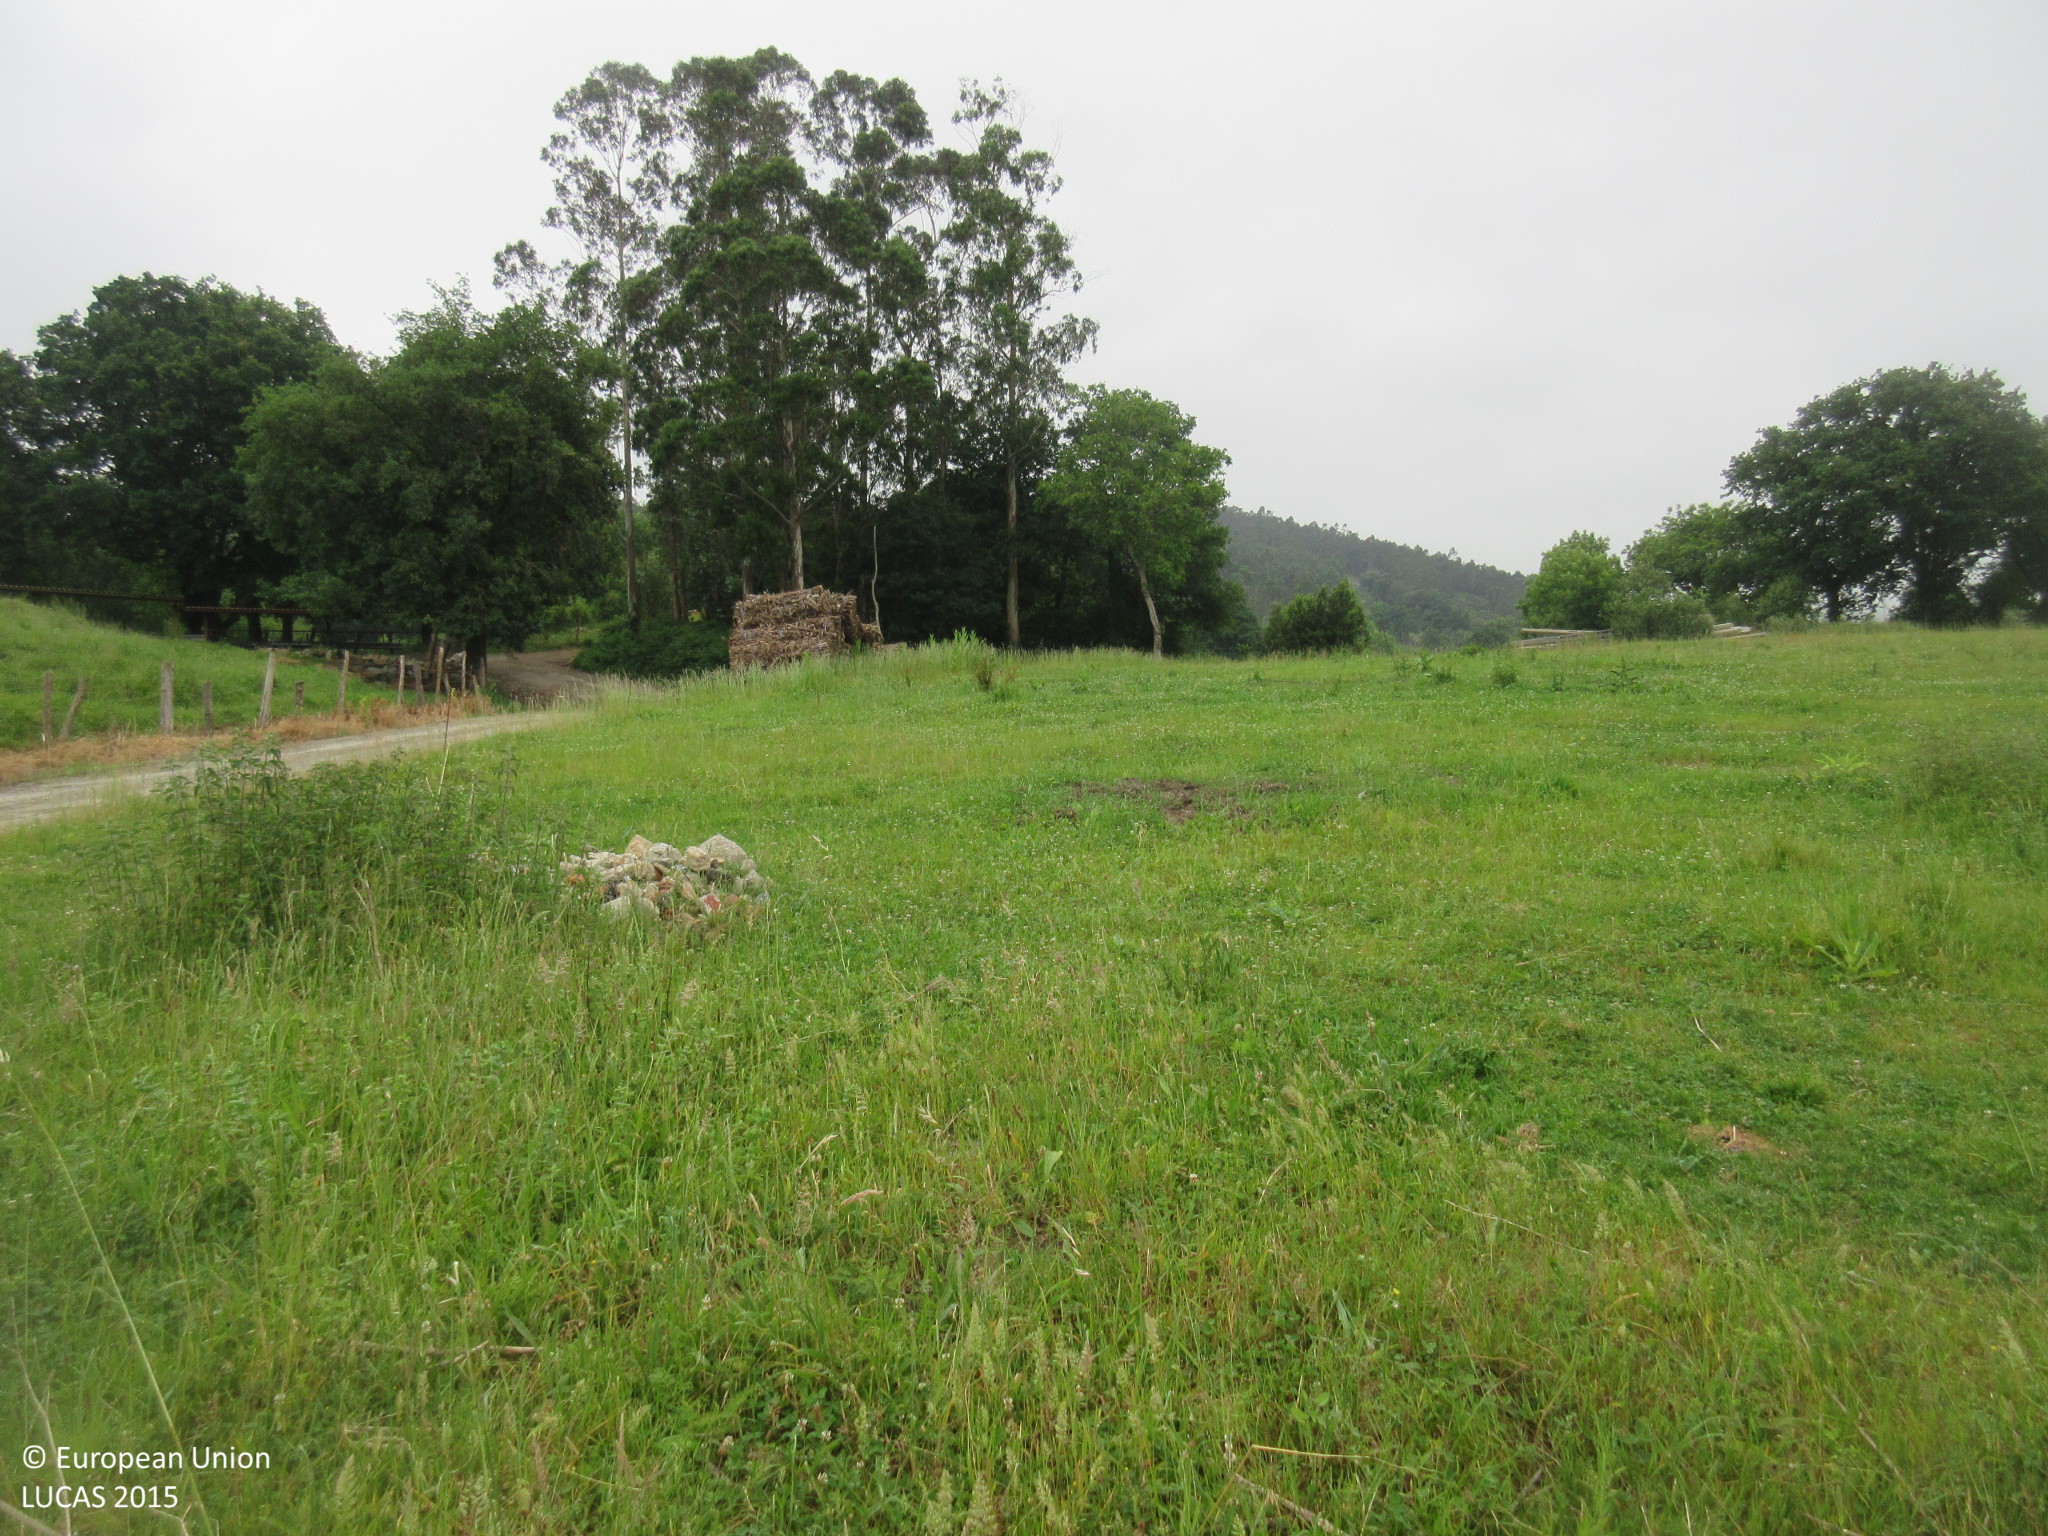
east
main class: Grassland
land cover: Grassland without tree/shrub cover
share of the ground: > 75 %
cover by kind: herbaceous plants 100 %
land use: Agriculture (excluding fallow land and kitchen gardens)
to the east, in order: Grassland without tree/shrub cover; Tracks; Broadleaved woodland; Fences; Tracks; Shruby margins; Fences; Grassland with sparse tree/shrub cover
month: June
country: ES
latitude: 43.3793
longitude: -3.5850
